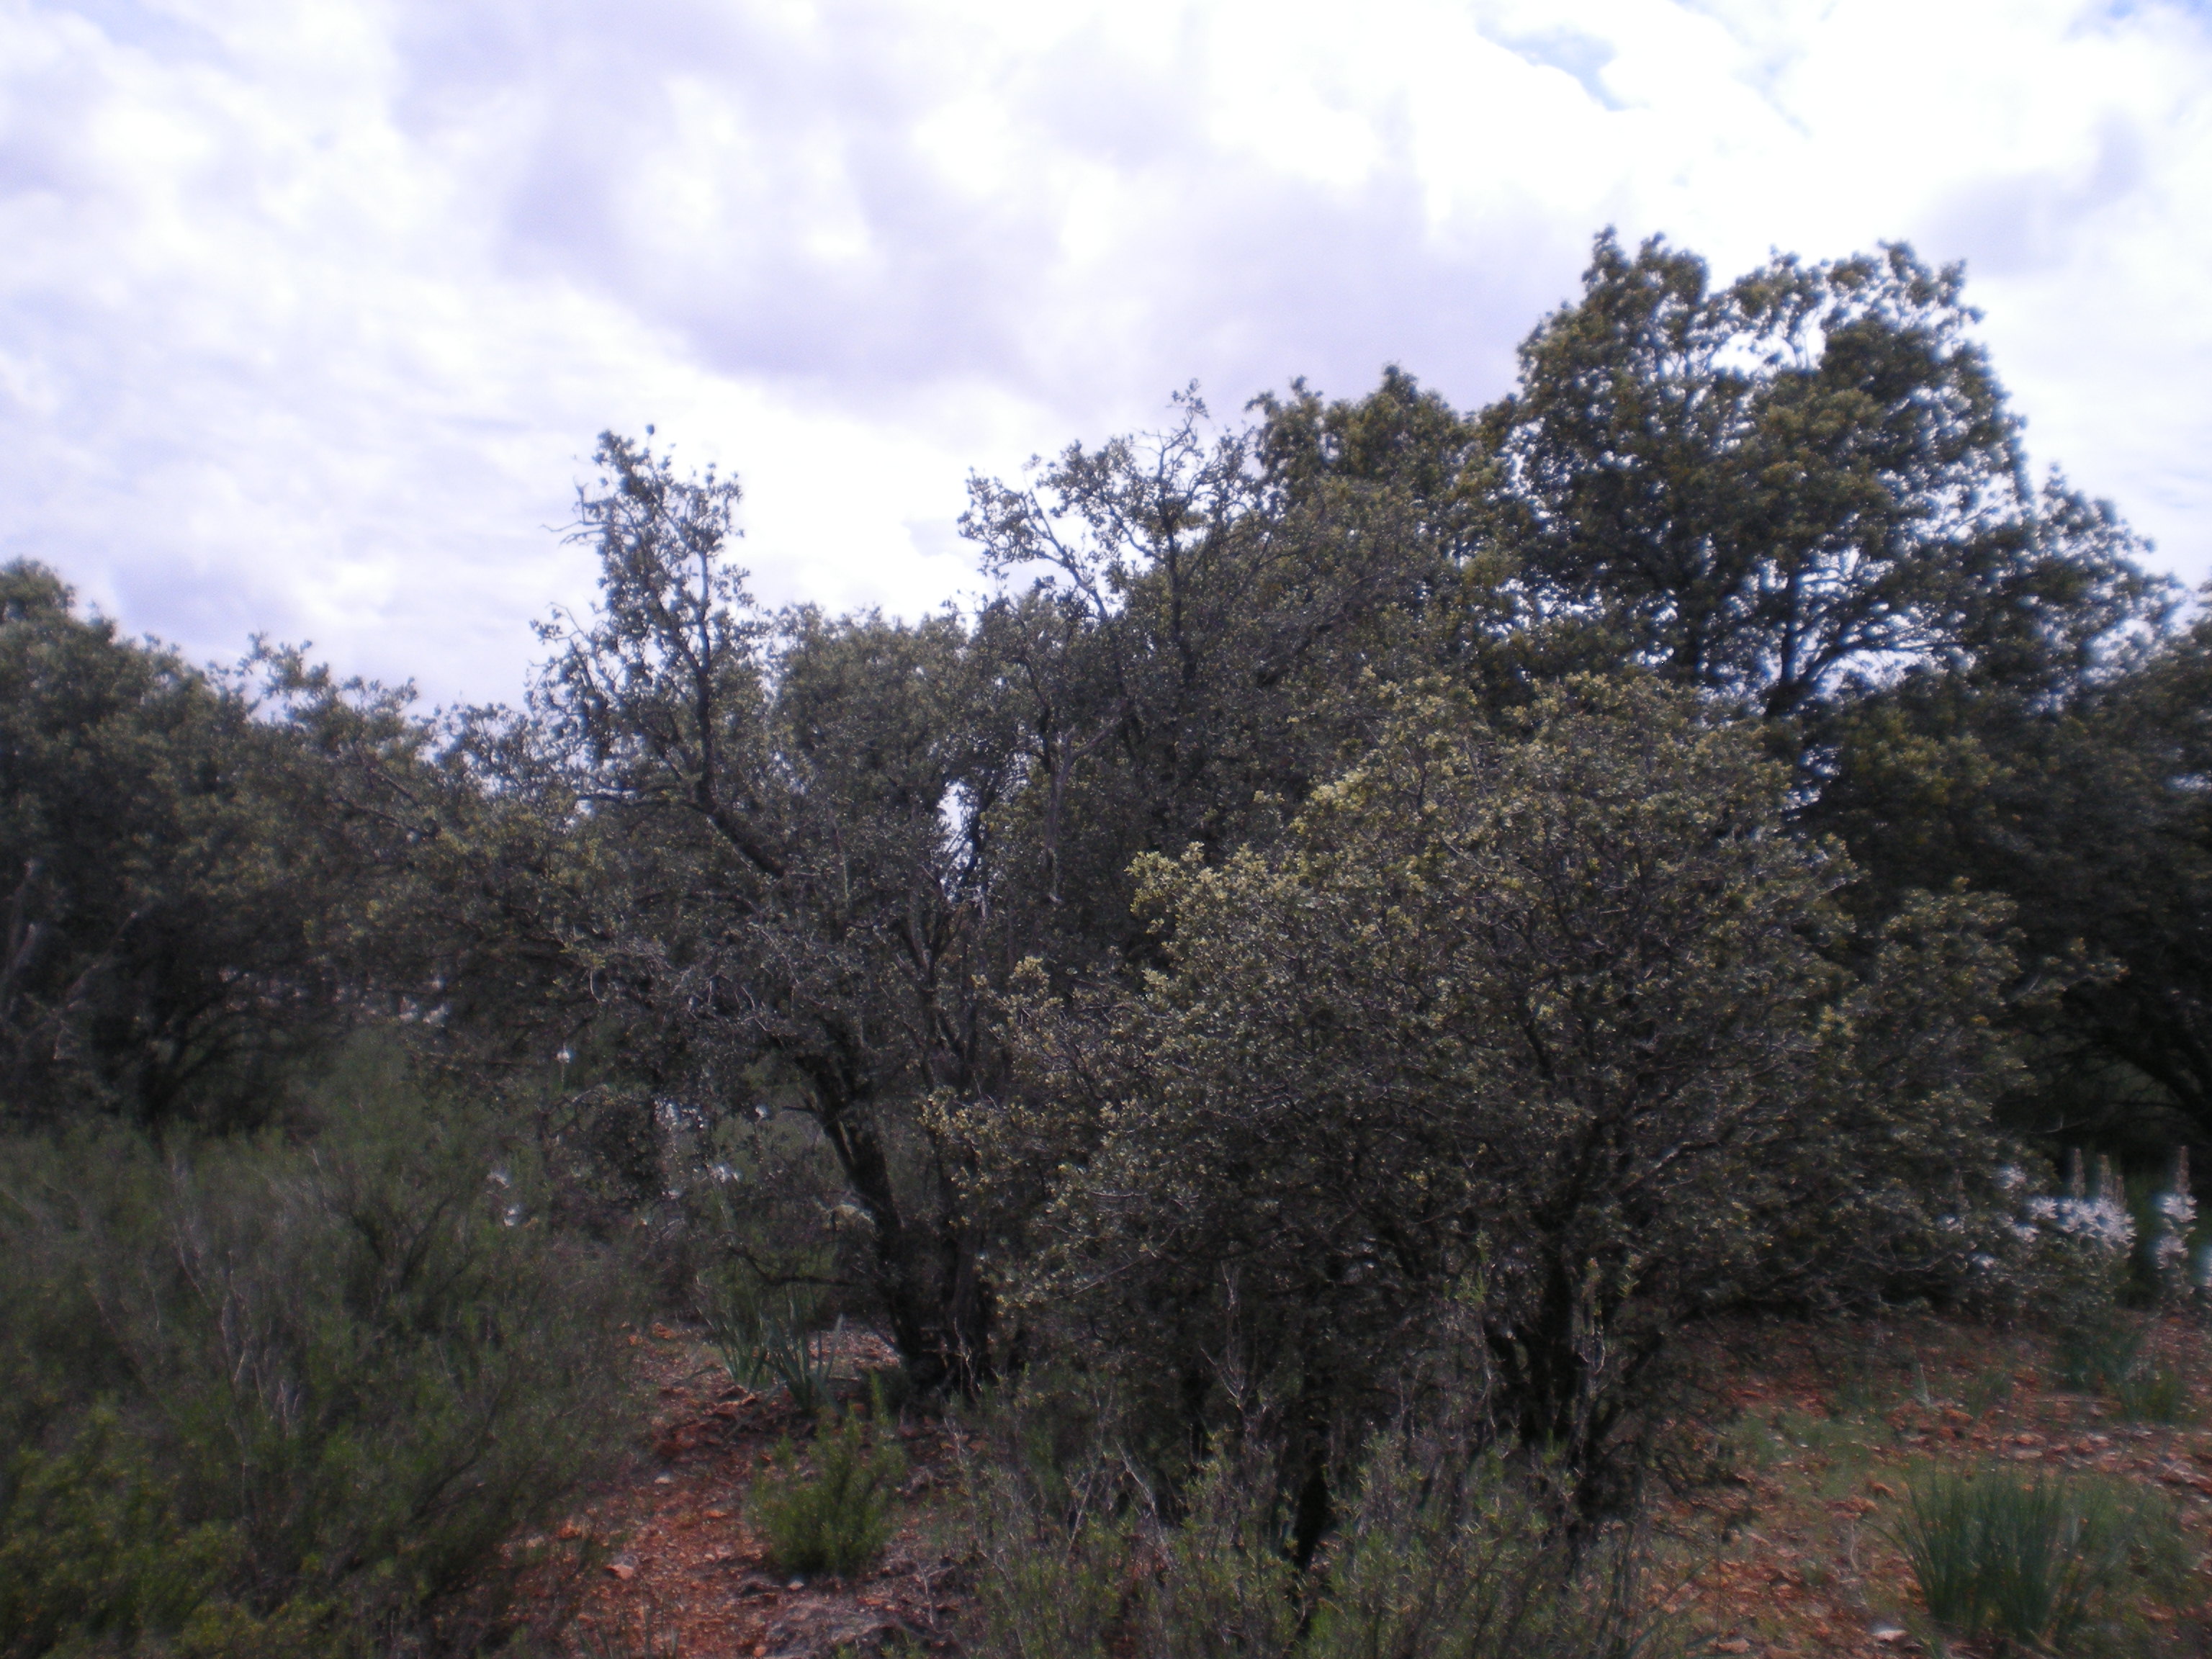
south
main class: Woodland
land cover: Broadleaved woodland
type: broadleaved evergreen forest
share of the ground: 50 - 75 %
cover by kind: broadleaved forest trees 30 %, shrubs 30 %, herbaceous plants 20 %, unconsolidated bare surface 20 %
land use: Other primary production
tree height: < 5 m
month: May
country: ES
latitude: 38.9065
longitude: -2.9818
